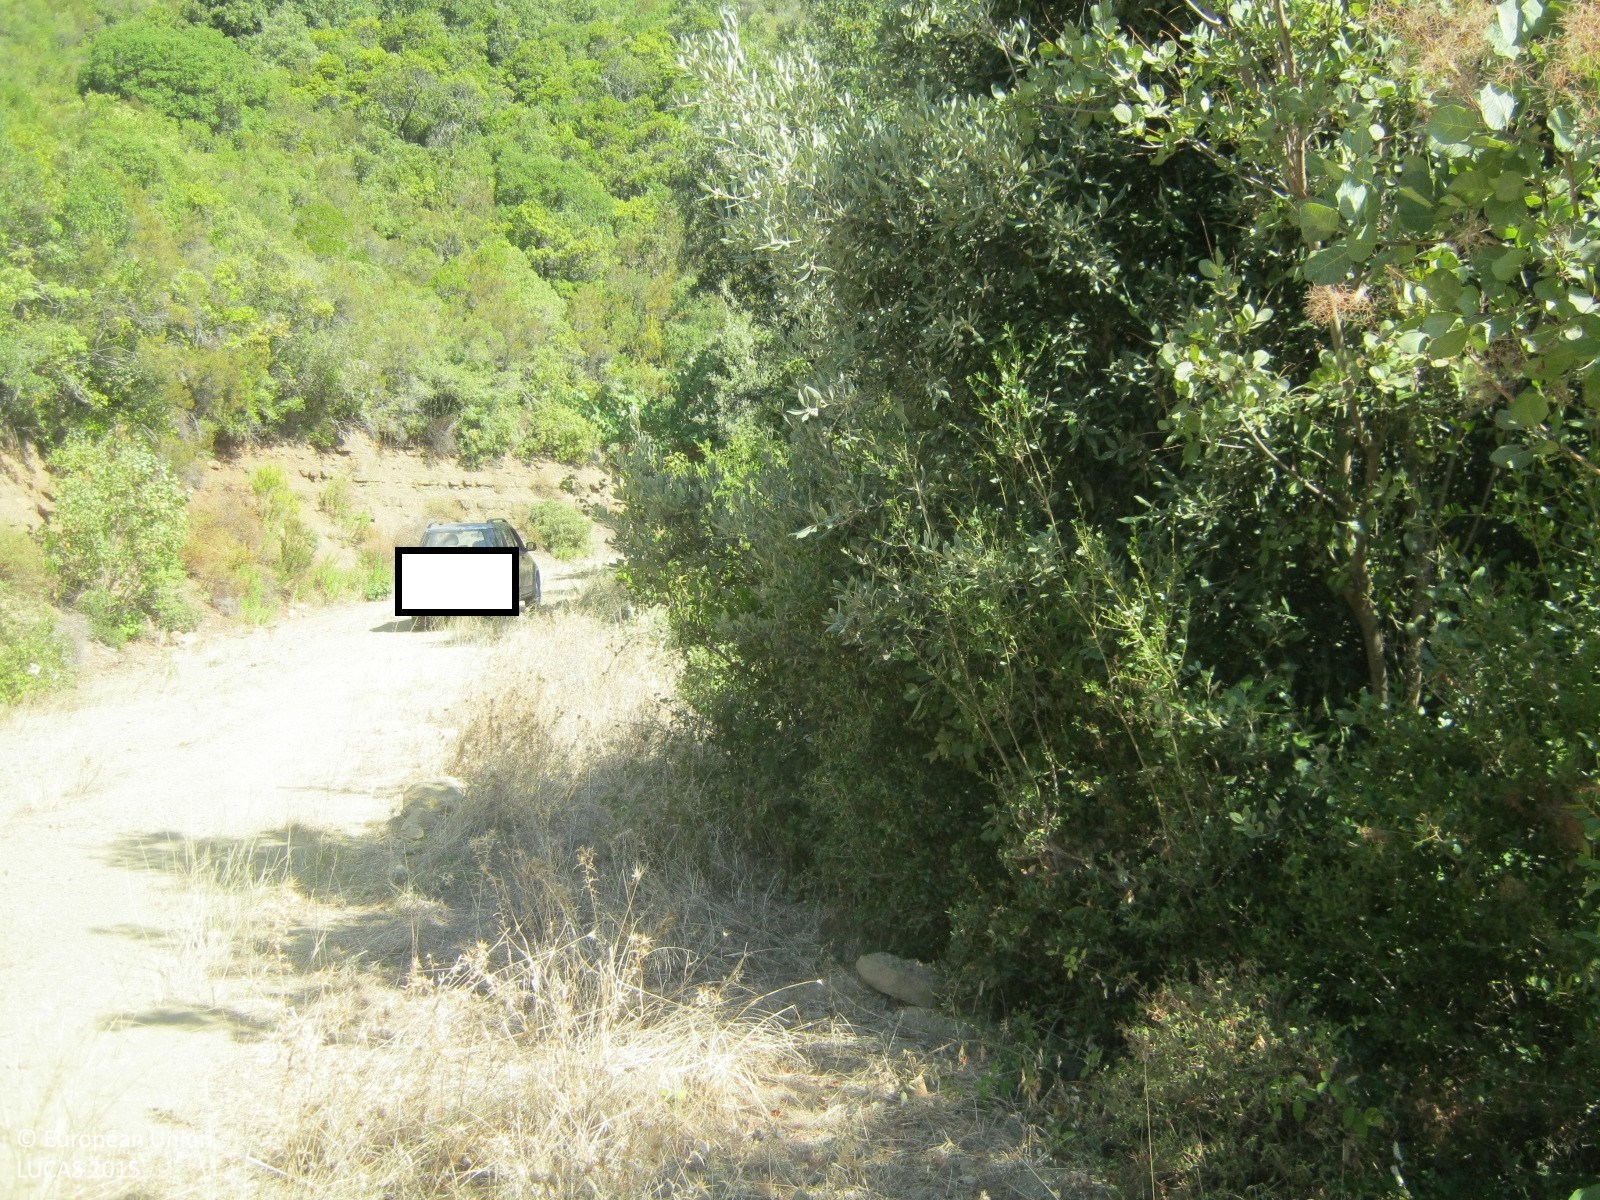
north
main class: Shrubland
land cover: Shrubland with sparse tree cover
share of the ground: > 75 %
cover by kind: shrubs 90 %, broadleaved forest trees 5 %, herbaceous plants 5 %
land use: Agriculture (excluding fallow land and kitchen gardens)
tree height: > 5 m
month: September
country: GR
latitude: 39.2176
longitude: 21.0823
